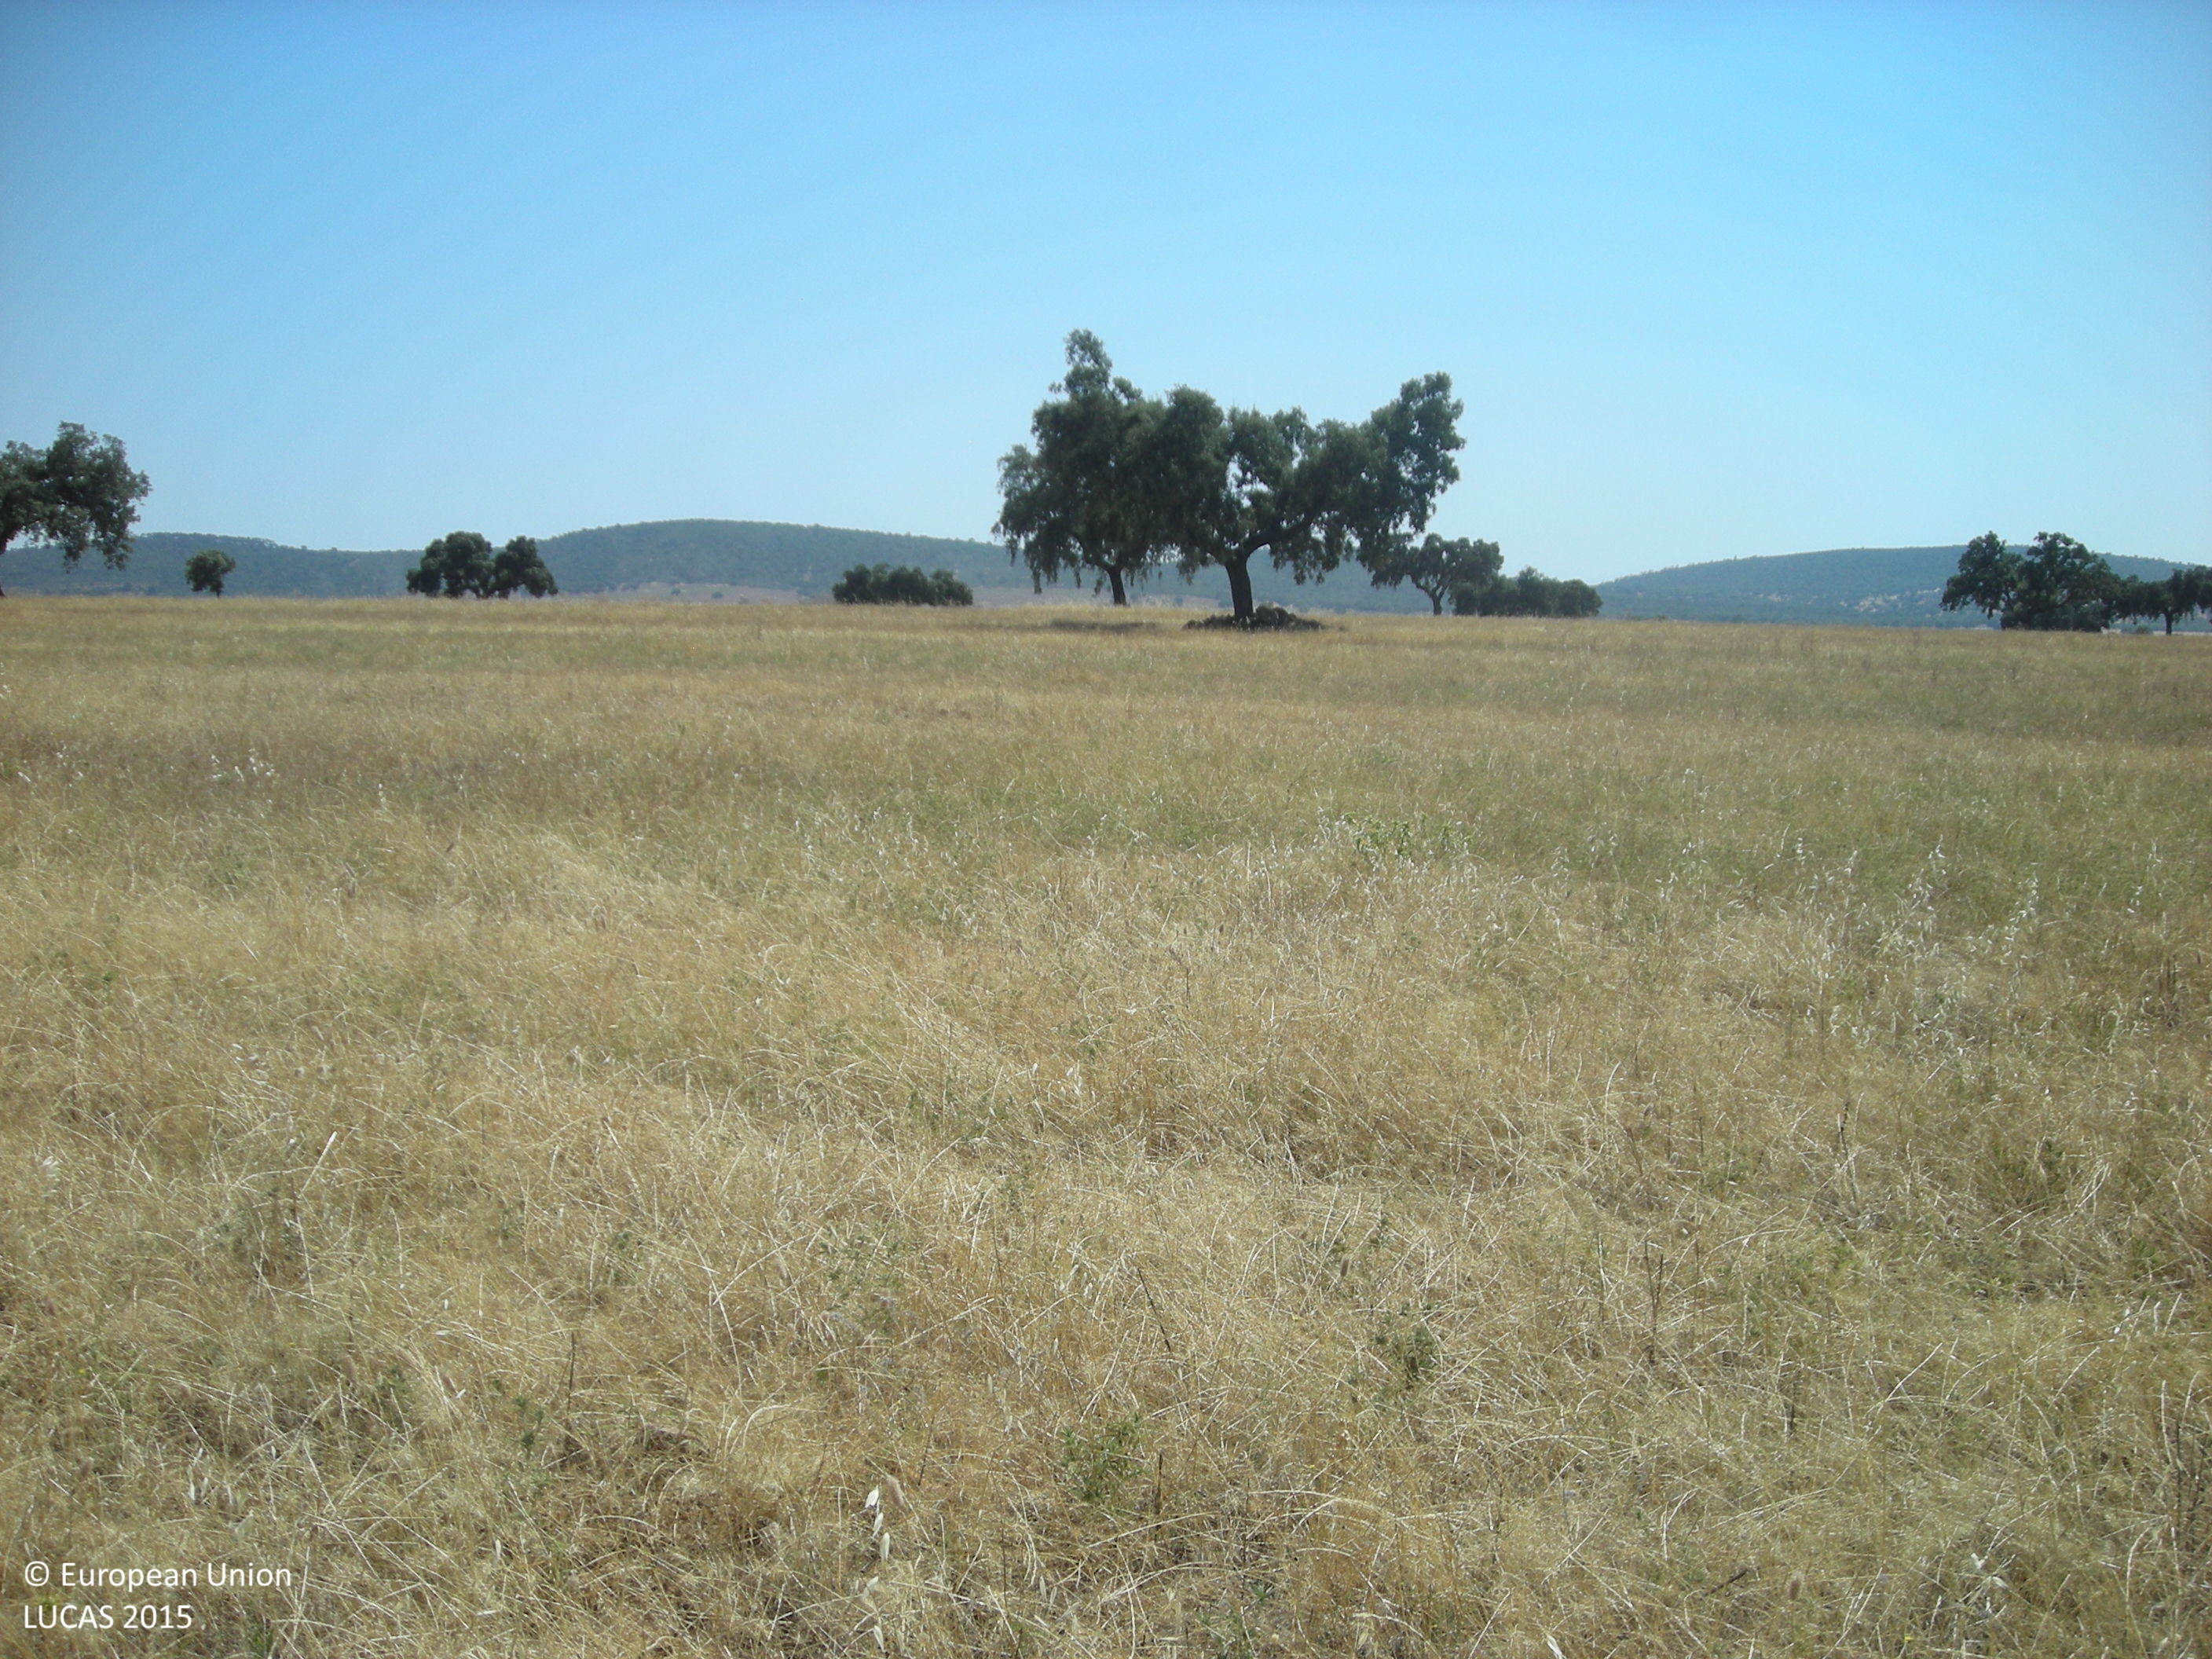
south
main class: Grassland
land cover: Grassland without tree/shrub cover
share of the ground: > 75 %
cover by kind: herbaceous plants 100 %
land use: Agriculture (excluding fallow land and kitchen gardens)
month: June
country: ES
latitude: 38.6148
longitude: -5.8812
